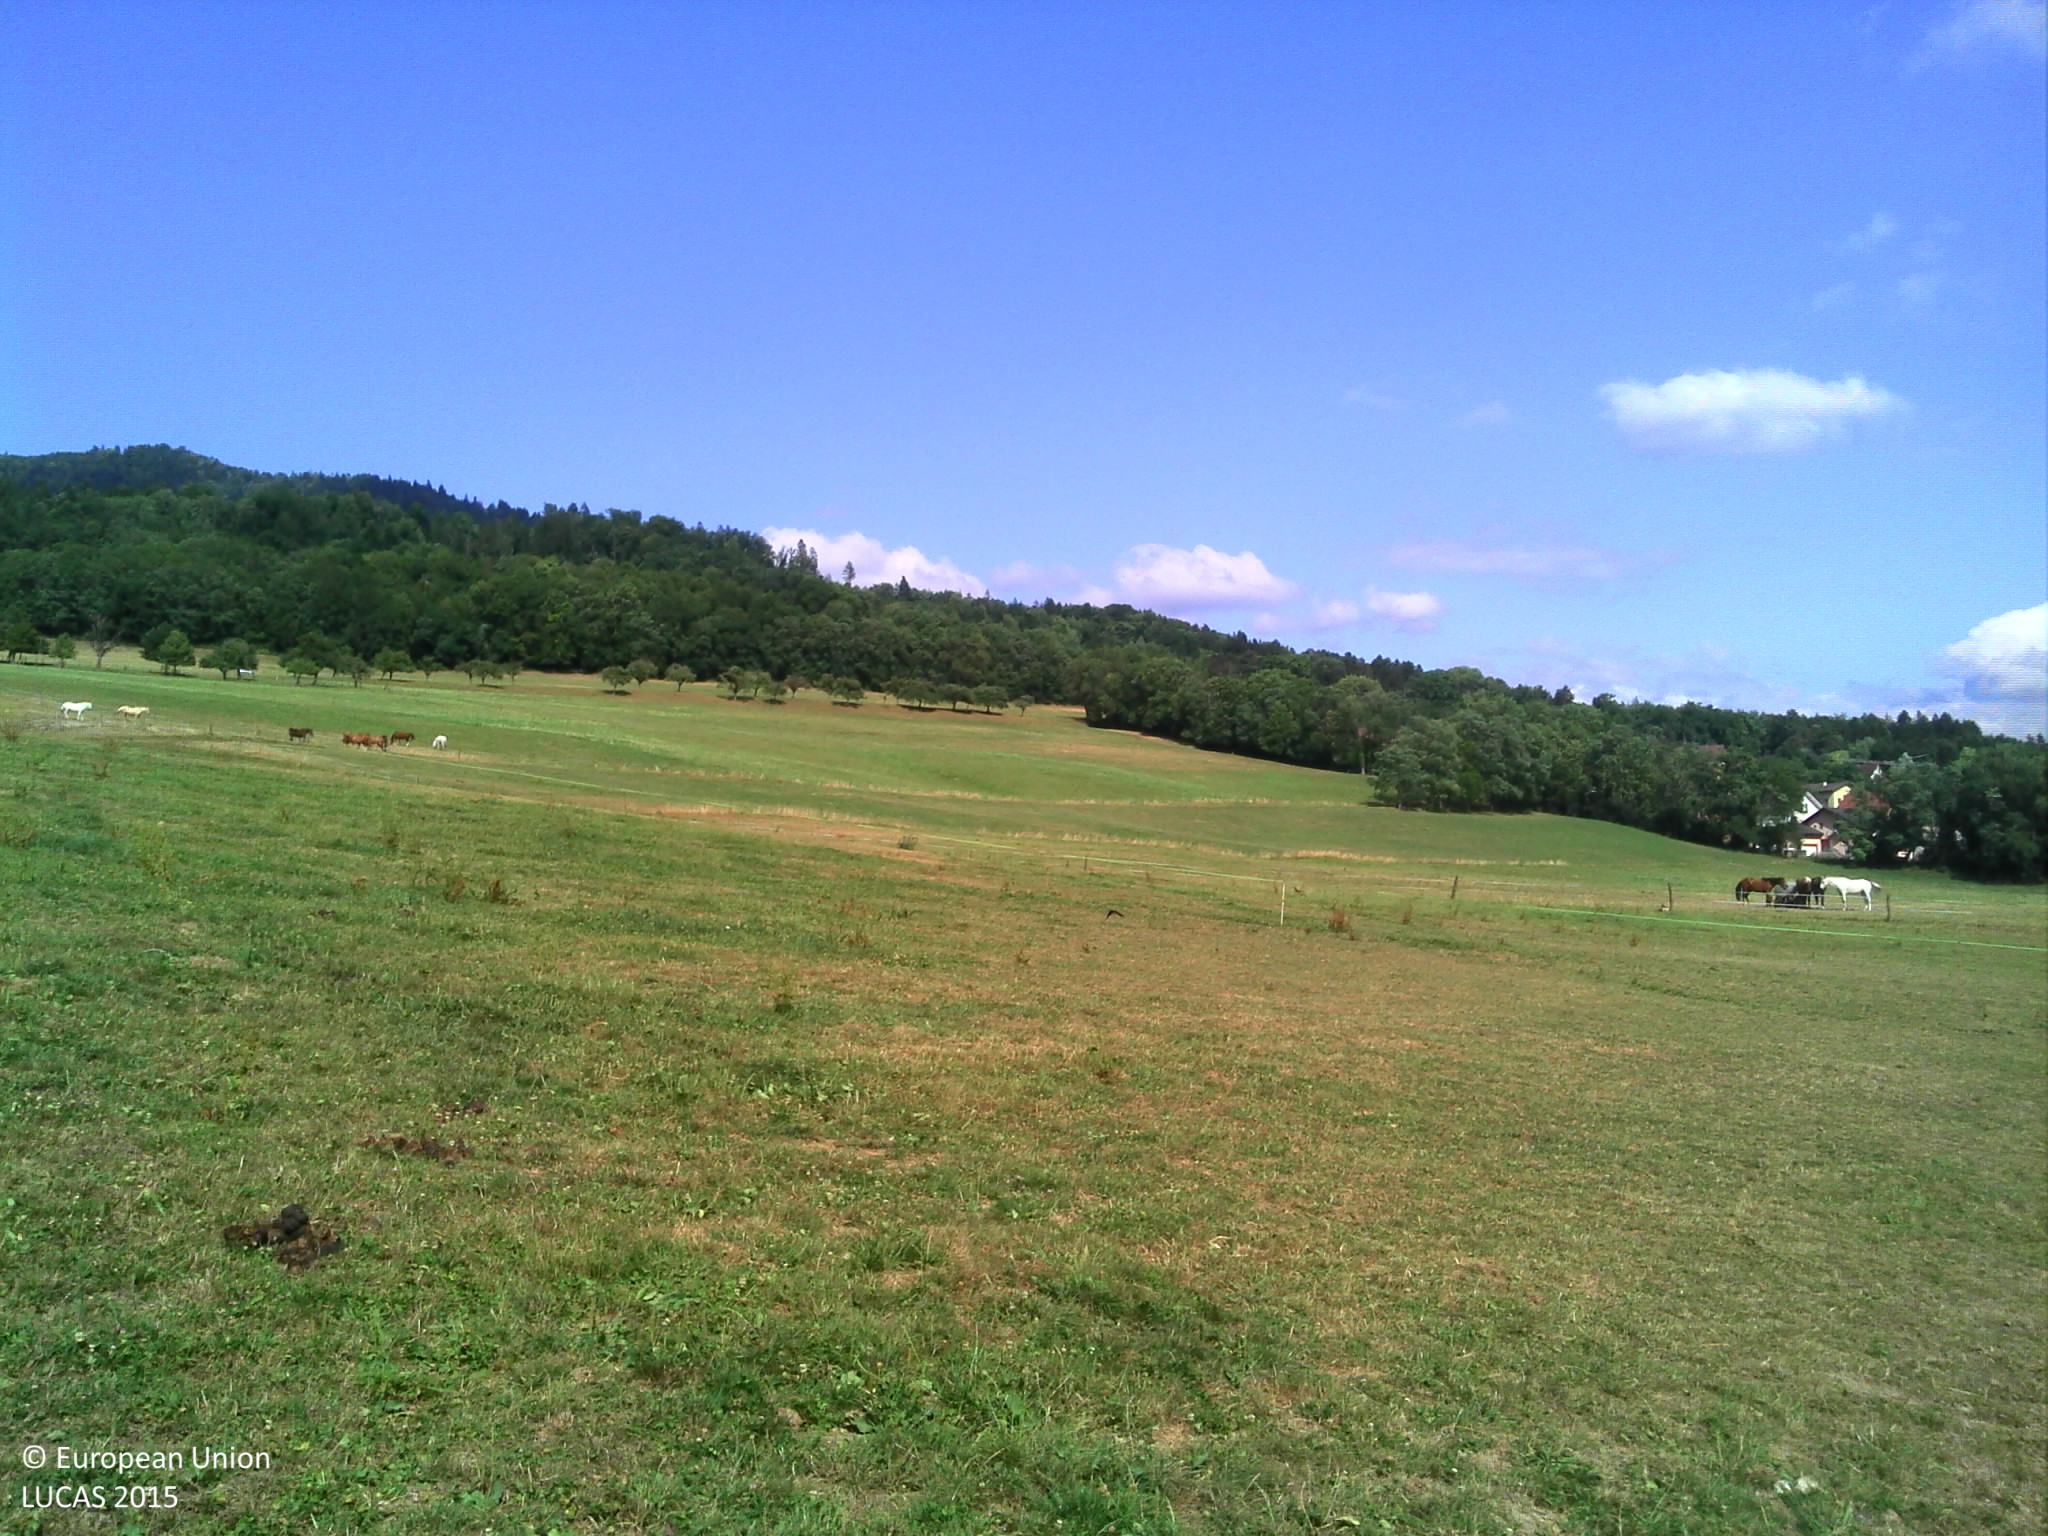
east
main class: Grassland
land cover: Grassland without tree/shrub cover
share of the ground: > 75 %
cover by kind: herbaceous plants 100 %
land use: Agriculture (excluding fallow land and kitchen gardens)
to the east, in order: Grassland without tree/shrub cover; Fences; Grassland without tree/shrub cover; Fences; Grassland without tree/shrub cover; Fences; Grassland without tree/shrub cover
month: July
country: FR
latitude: 46.1795
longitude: 6.3115
